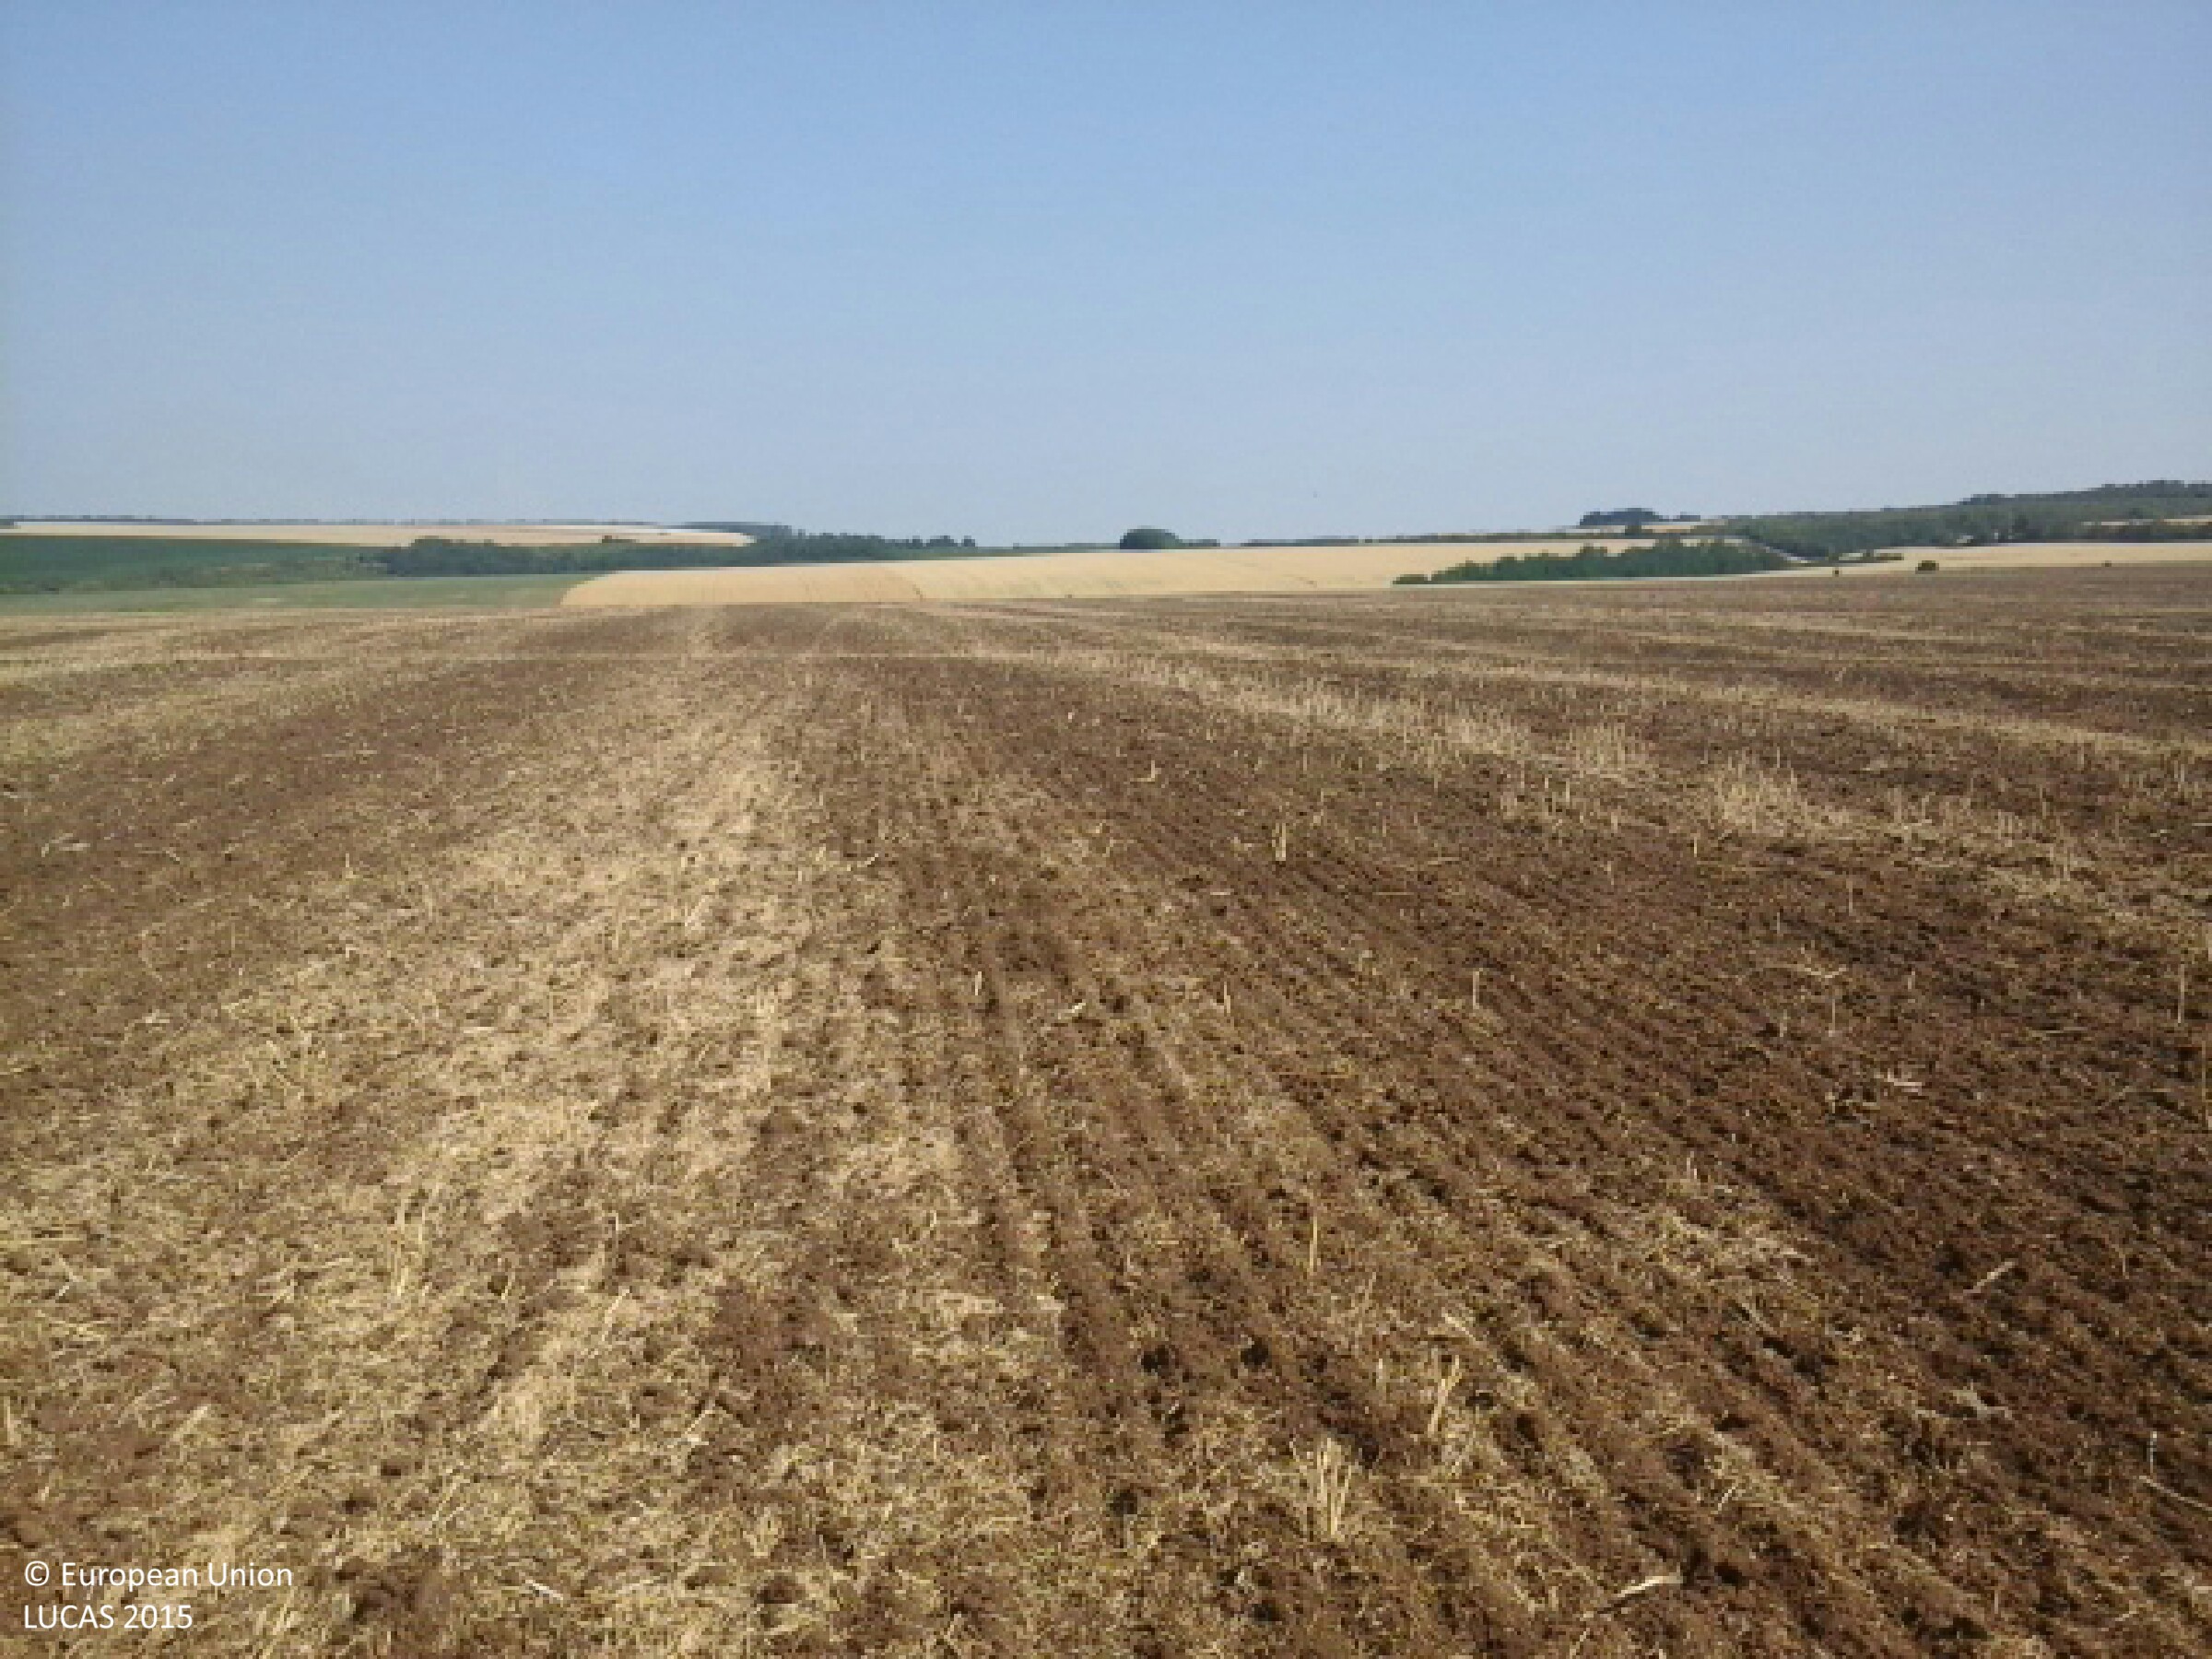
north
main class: Cropland
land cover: Rape and turnip rape
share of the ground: < 10 %
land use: Agriculture (excluding fallow land and kitchen gardens)
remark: Harvested field
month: July
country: HU
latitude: 48.1894
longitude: 21.0845
